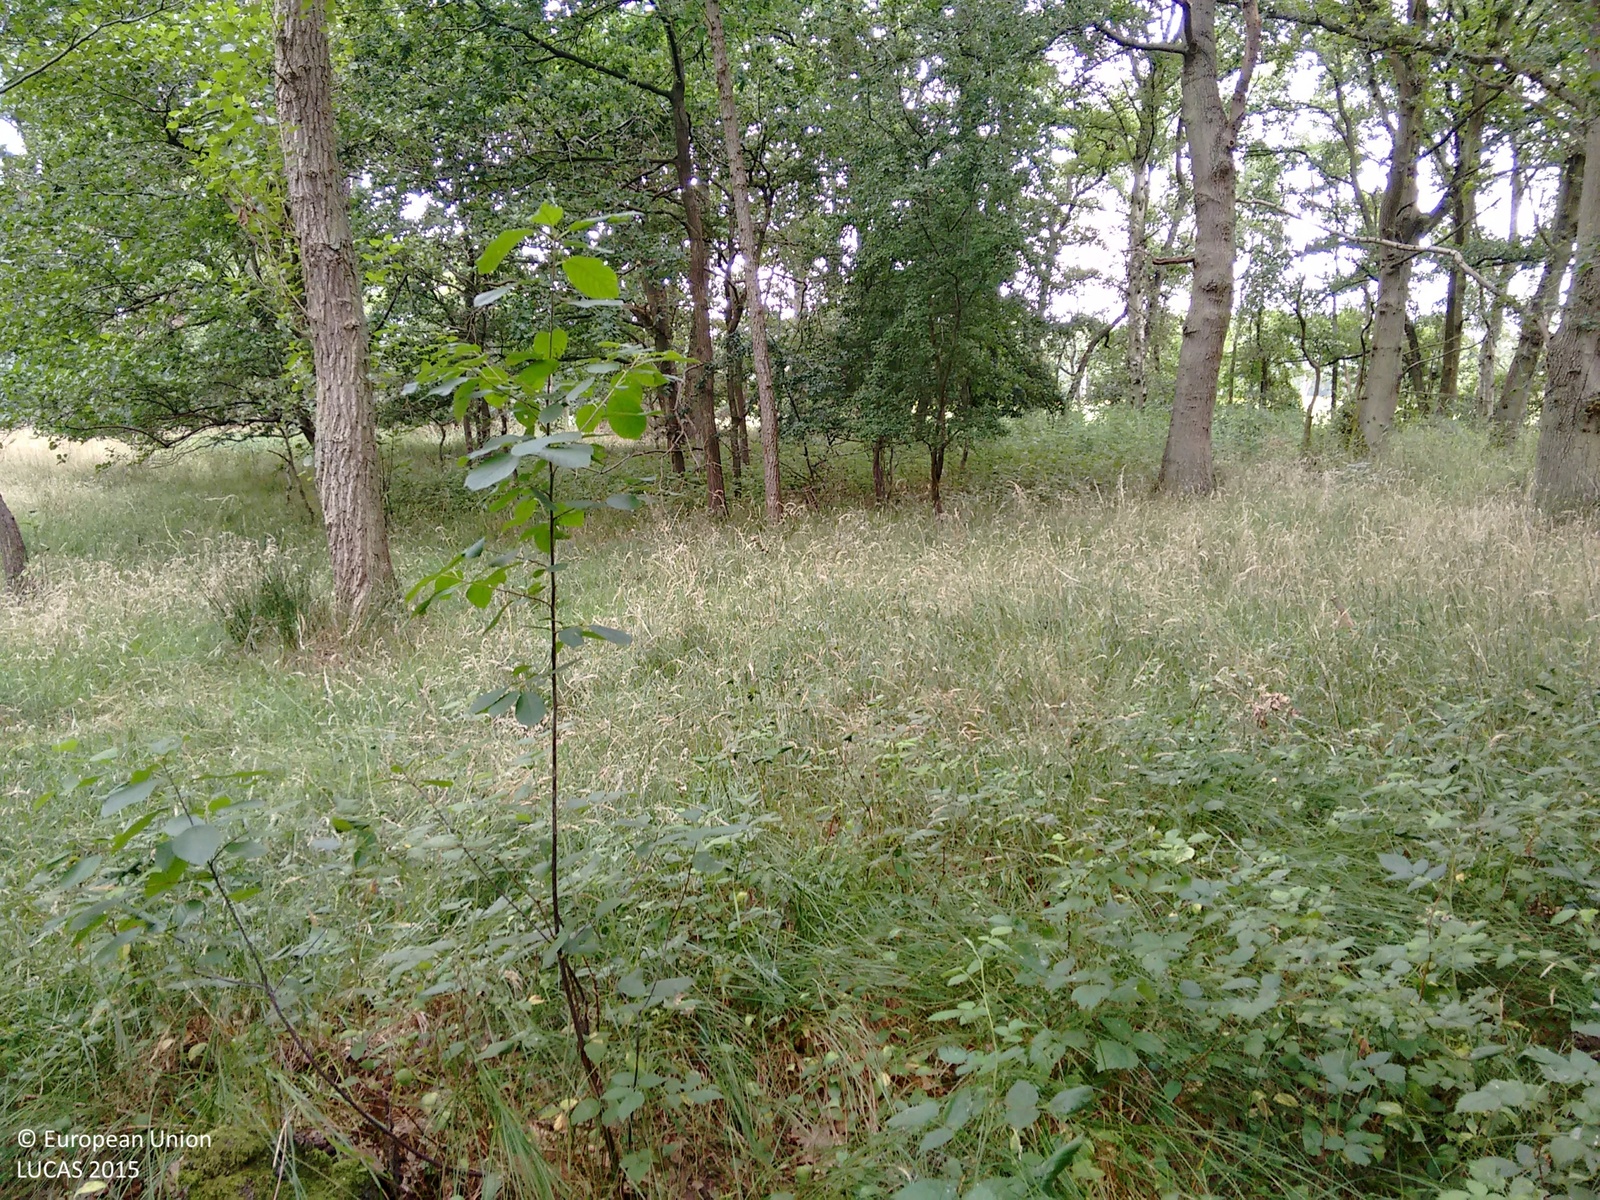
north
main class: Woodland
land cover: Broadleaved woodland
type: mesophytic deciduous forest
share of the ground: > 75 %
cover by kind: broadleaved forest trees 100 %
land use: Amenities, museums, leisure
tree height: > 5 m
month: August
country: GB
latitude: 52.3603
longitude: 0.5307
